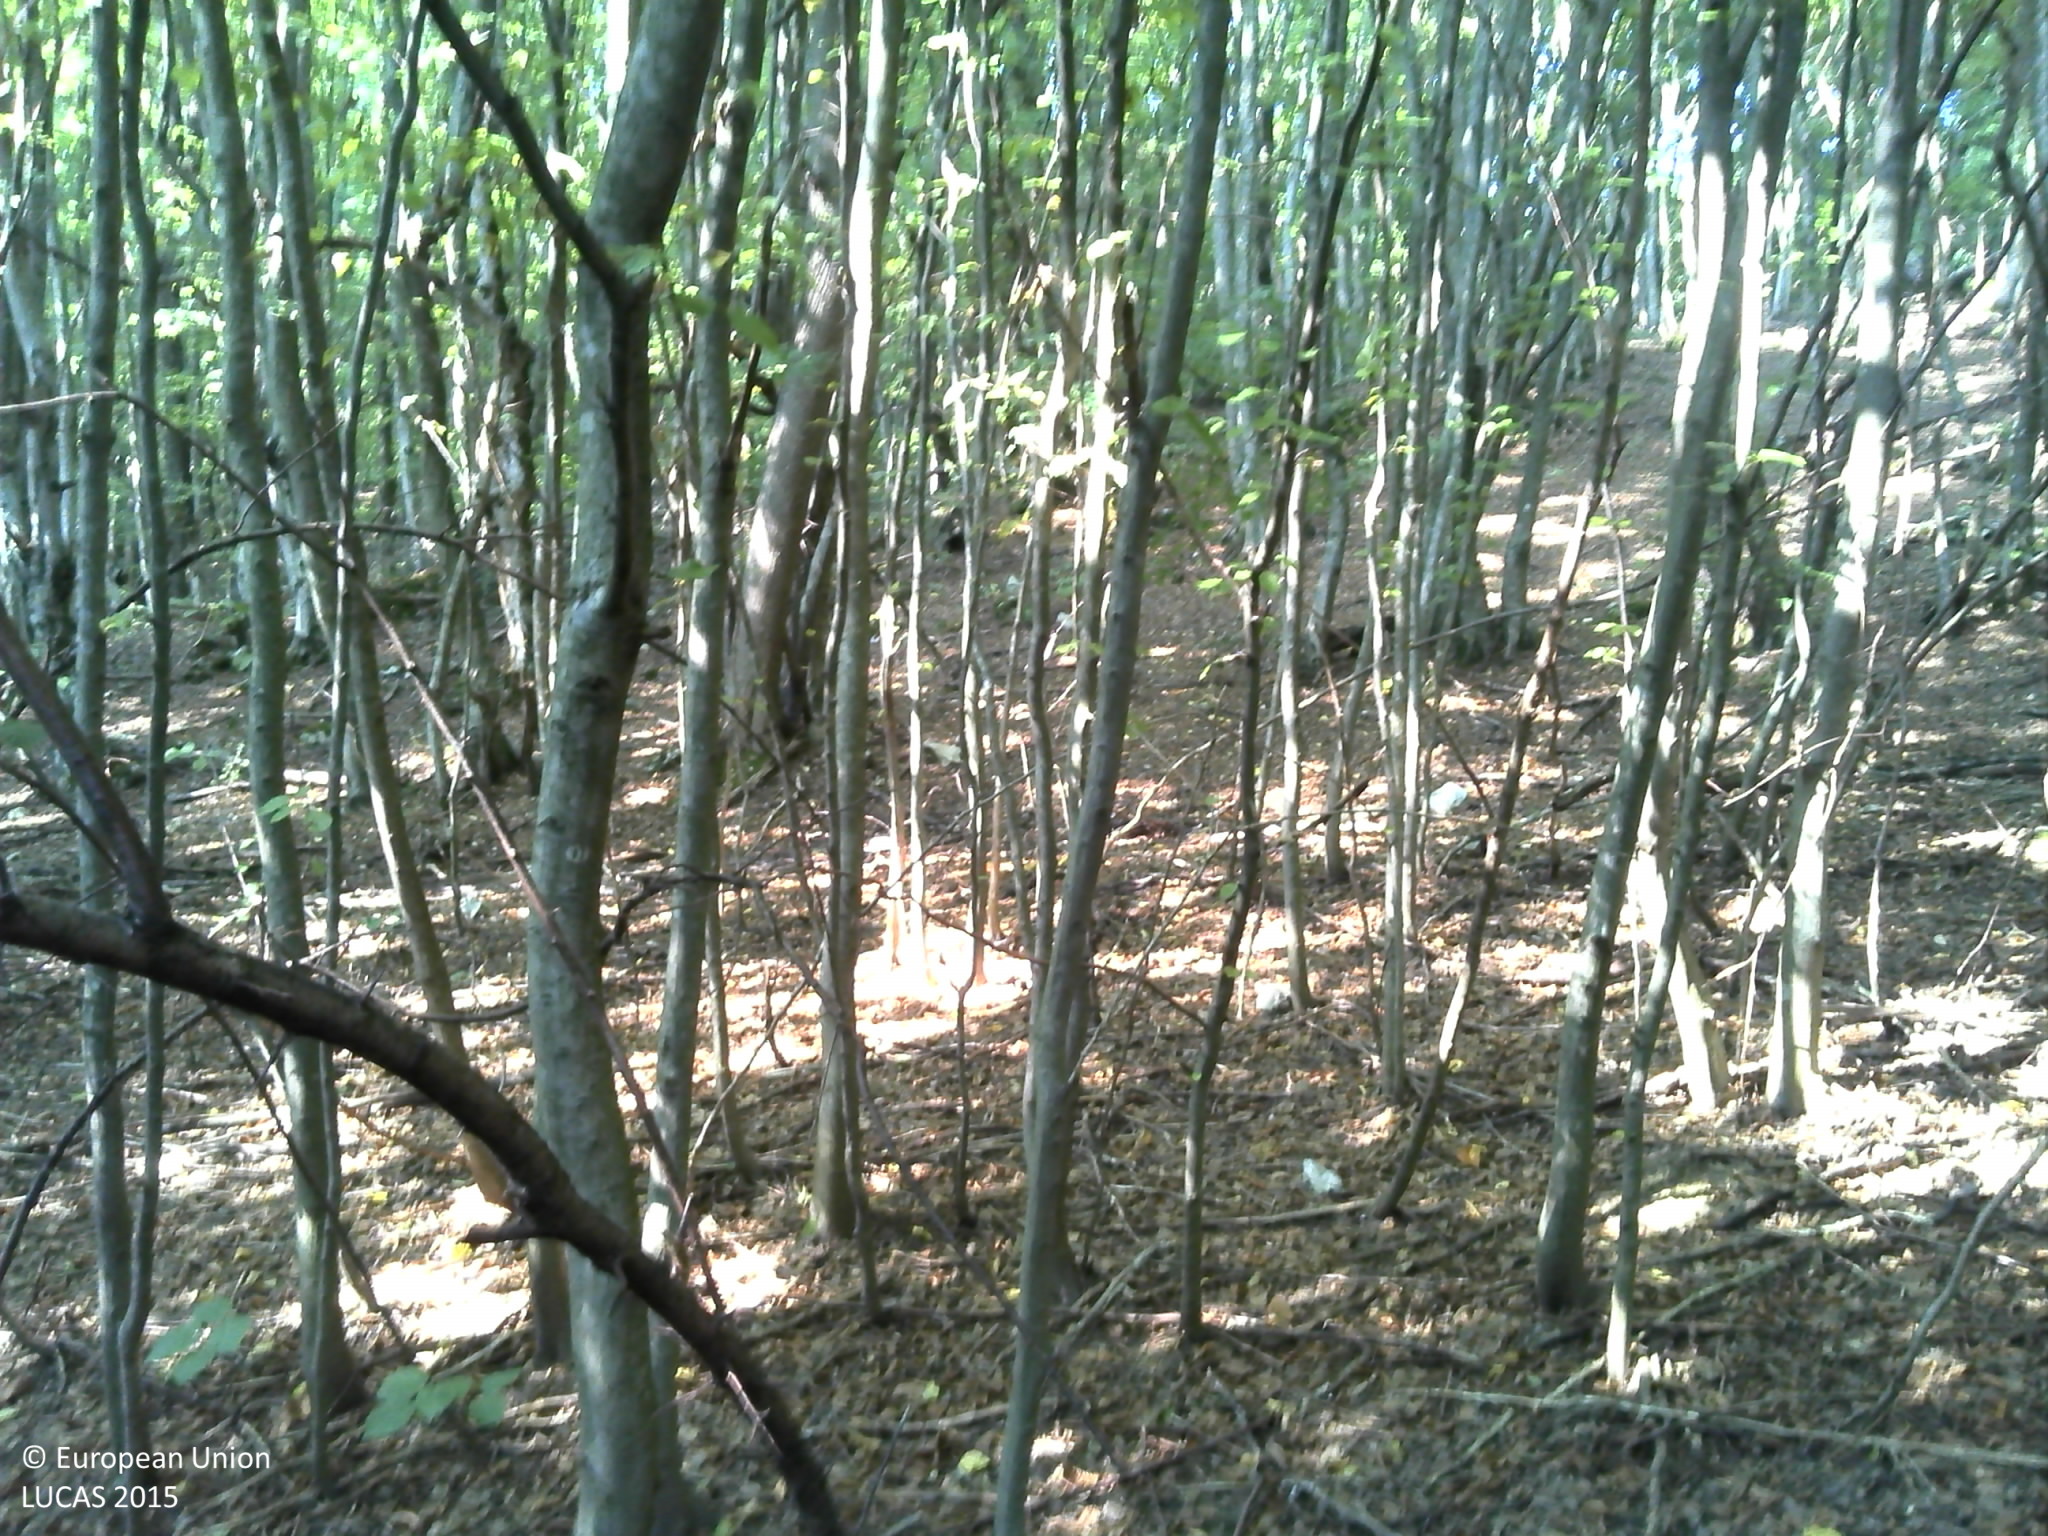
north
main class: Woodland
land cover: Broadleaved woodland
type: beech forest
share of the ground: > 75 %
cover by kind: broadleaved forest trees 100 %
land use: Forestry
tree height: > 5 m
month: August
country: HR
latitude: 45.1822
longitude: 16.4237
